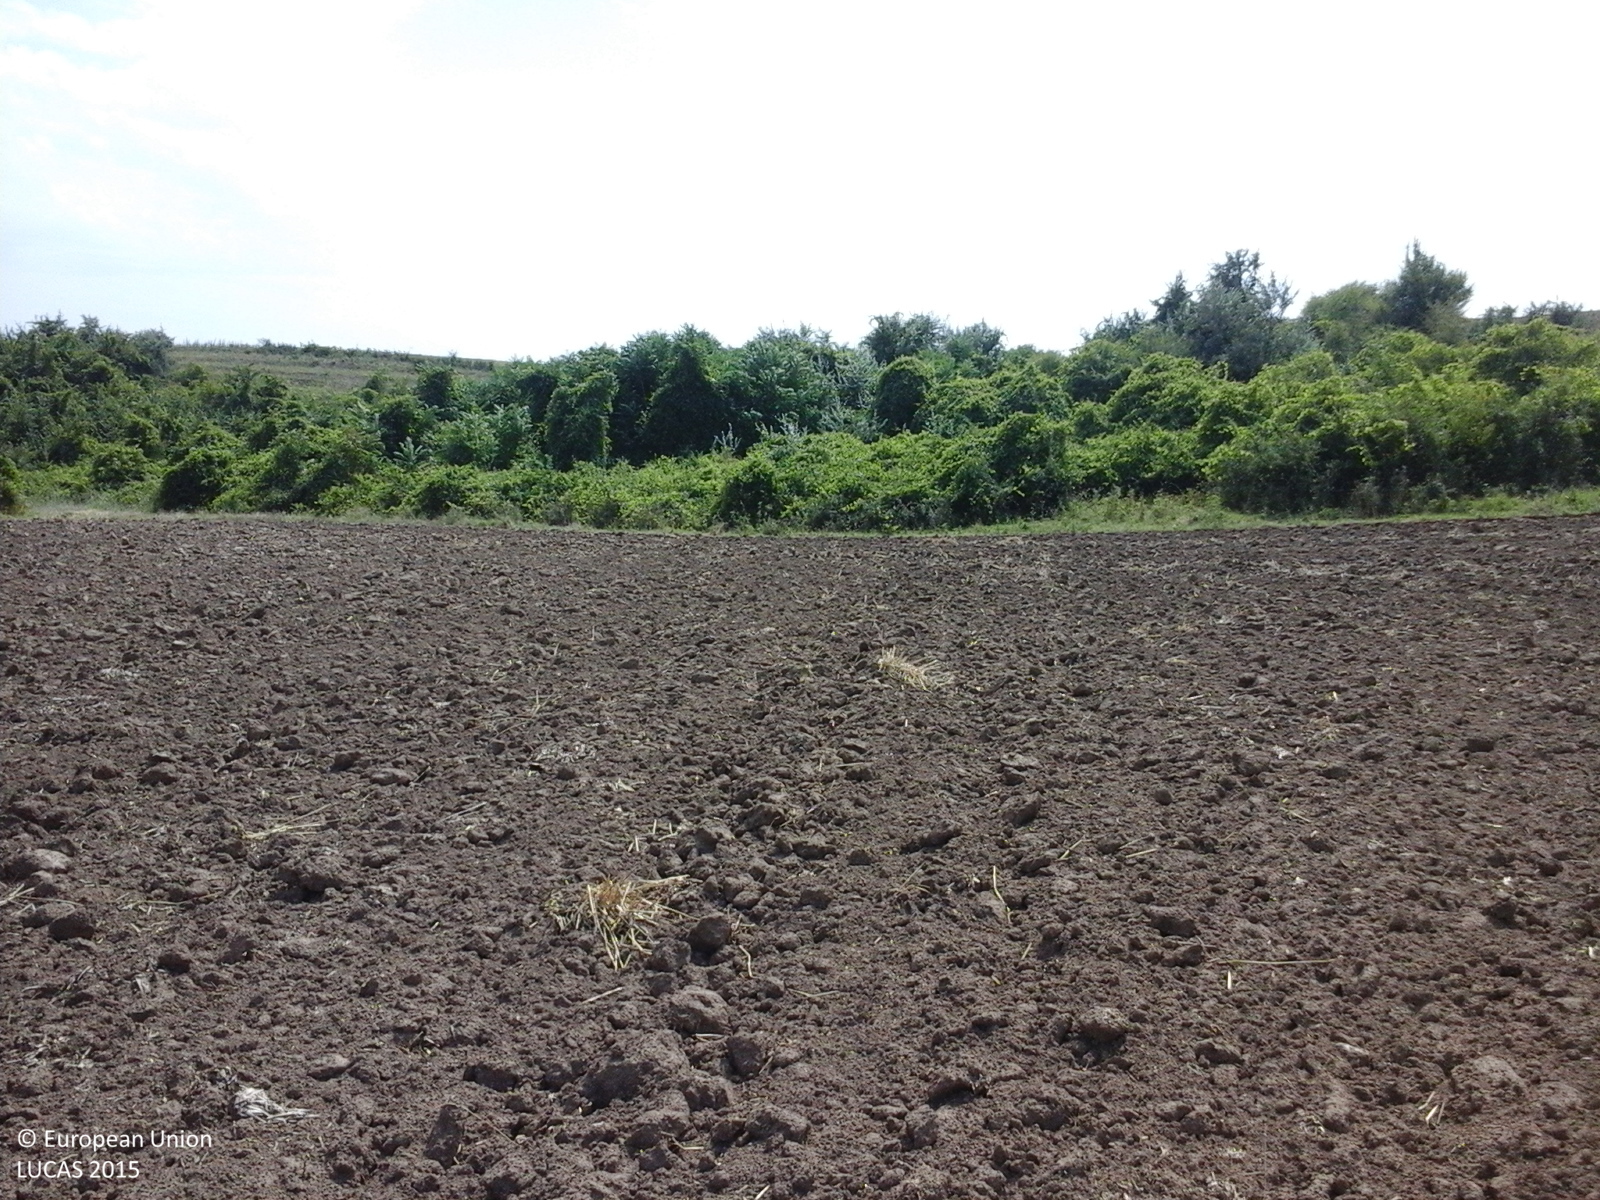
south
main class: Cropland
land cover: Common wheat
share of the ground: < 10 %
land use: Agriculture (excluding fallow land and kitchen gardens)
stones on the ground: < 10 %
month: August
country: RO
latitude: 44.1615
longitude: 27.6888
